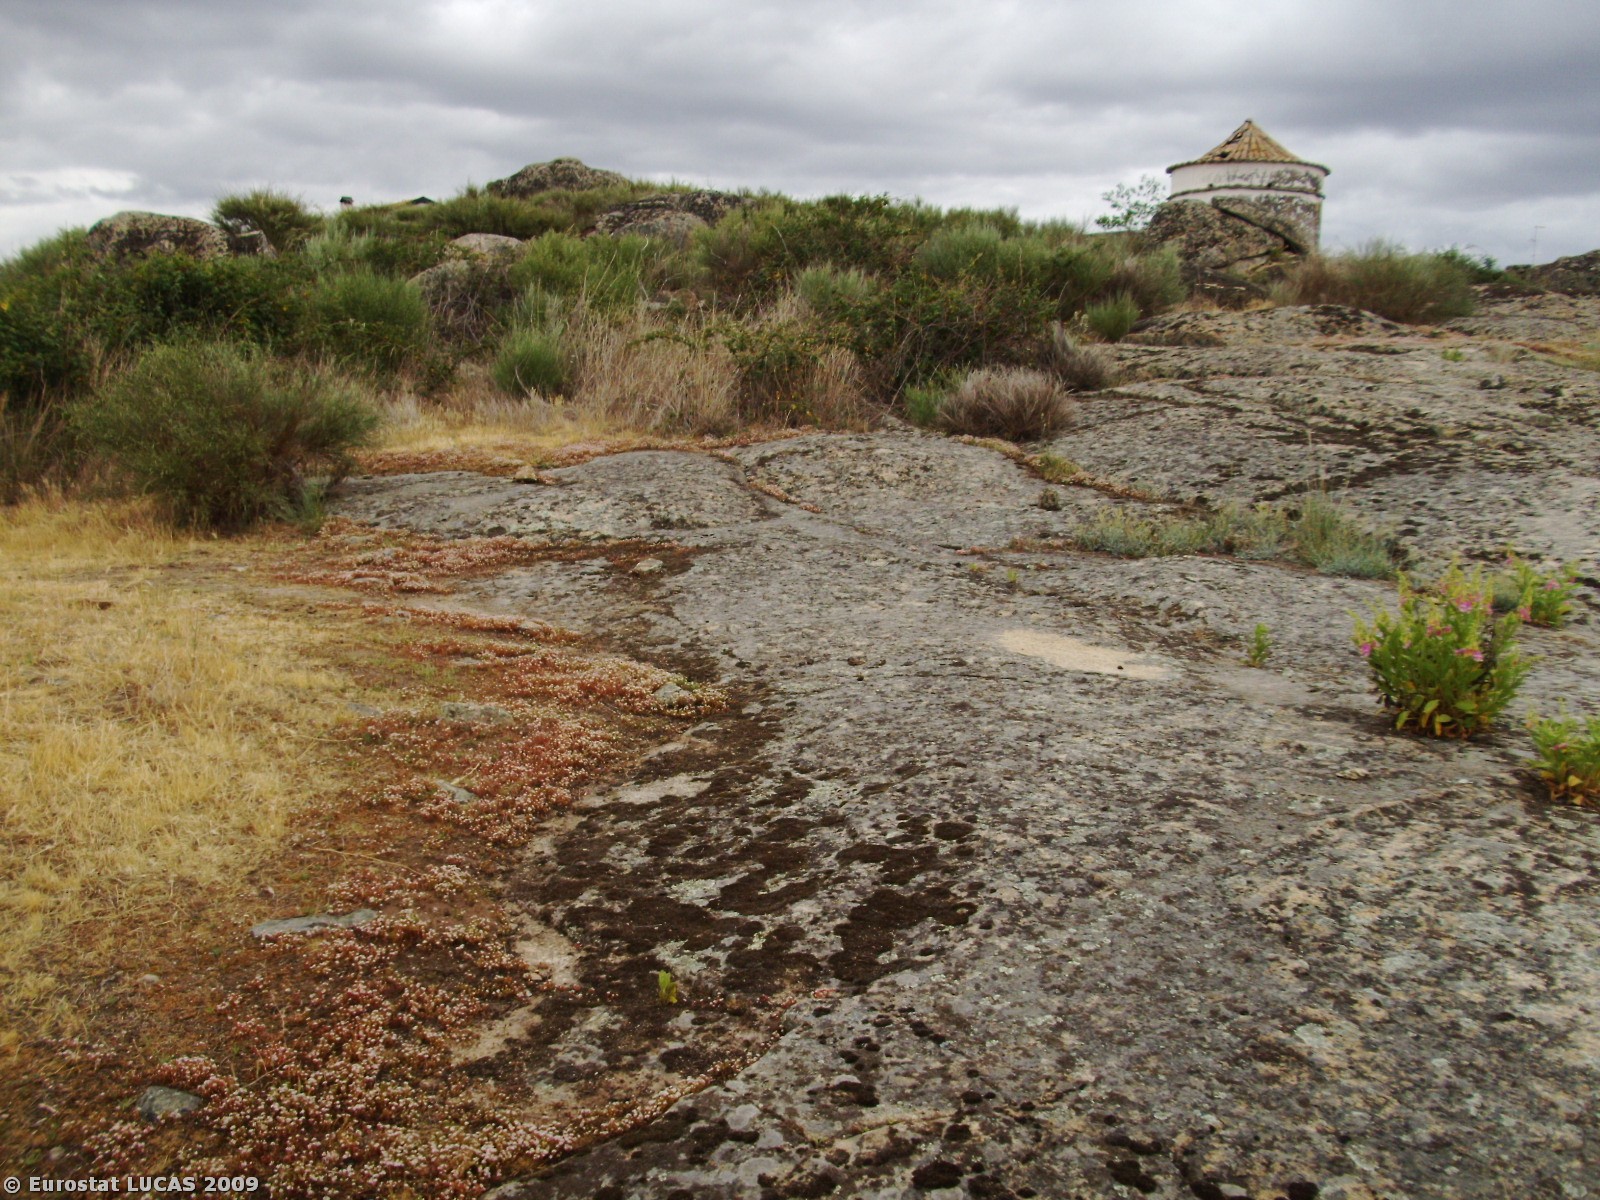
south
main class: Shrubland
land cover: Shrubland without tree cover
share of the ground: 25 - 50 %
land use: Unused
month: May
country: PT
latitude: 40.9909
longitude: -7.1684
